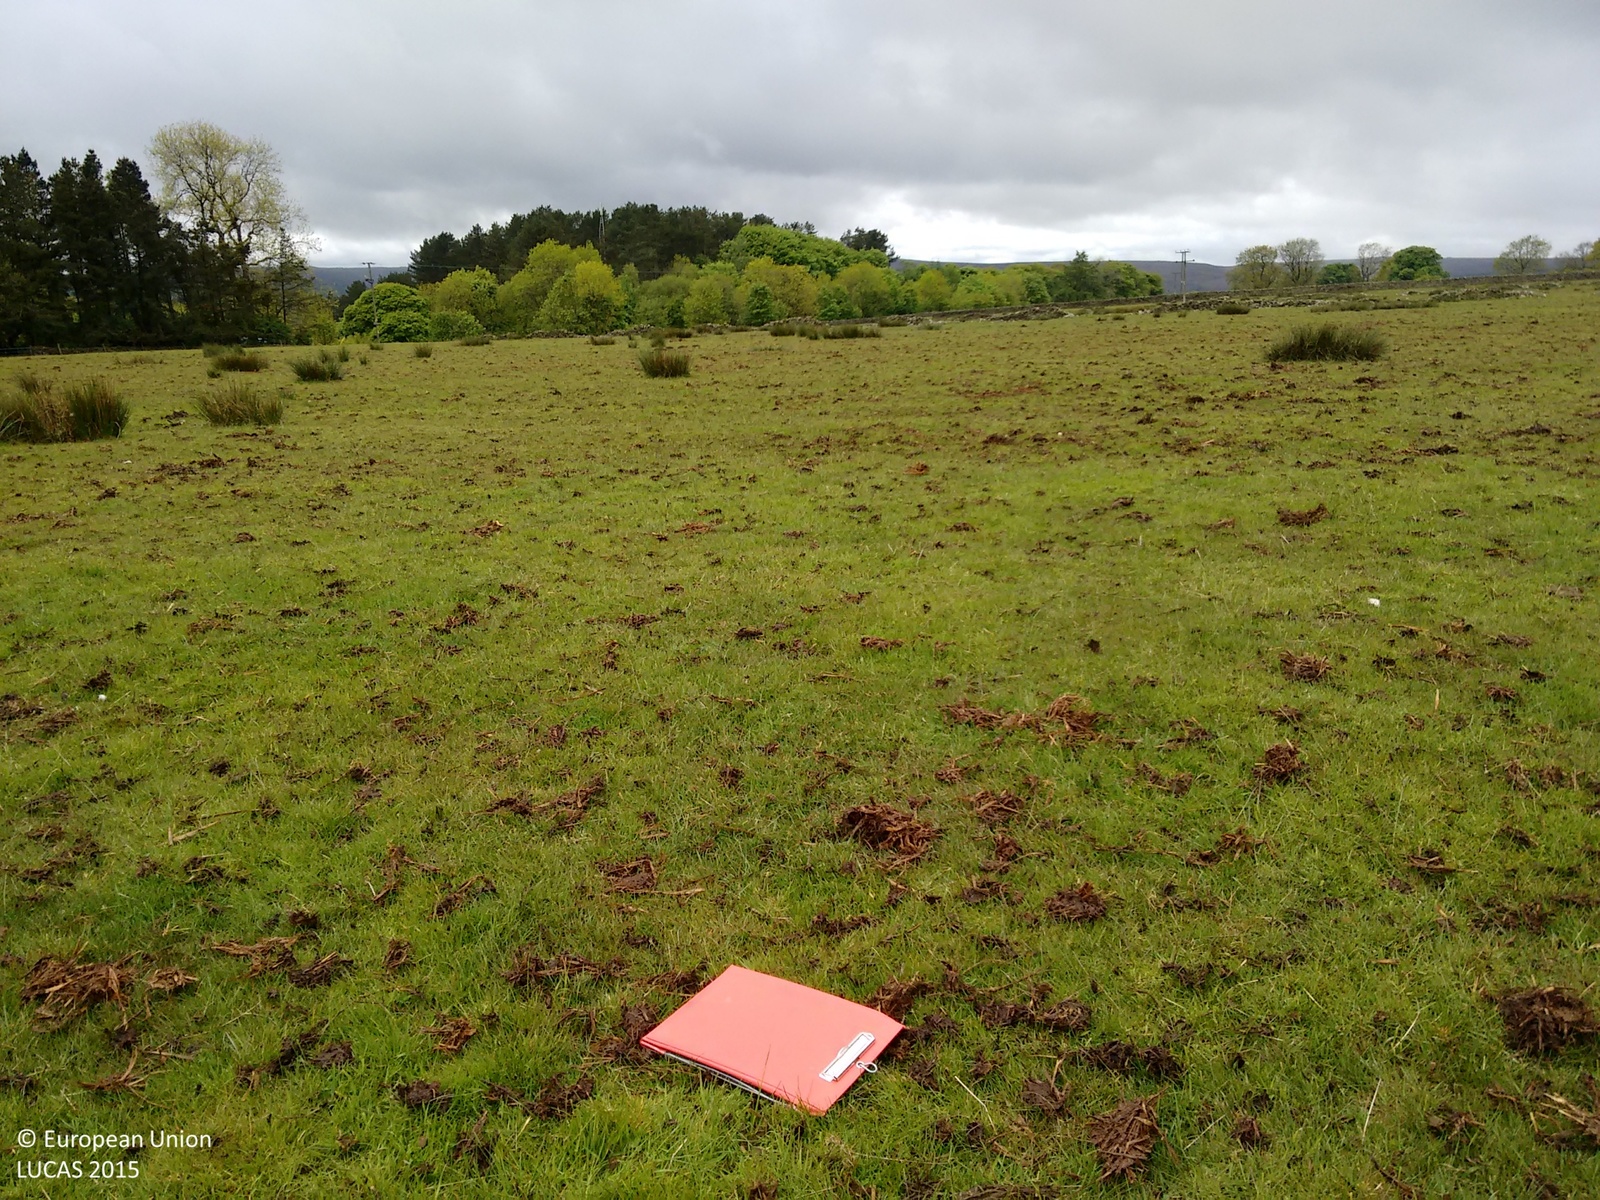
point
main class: Grassland
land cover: Grassland without tree/shrub cover
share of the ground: > 75 %
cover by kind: herbaceous plants 100 %
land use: Agriculture (excluding fallow land and kitchen gardens)
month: May
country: GB
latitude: 53.9937
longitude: -1.7214
